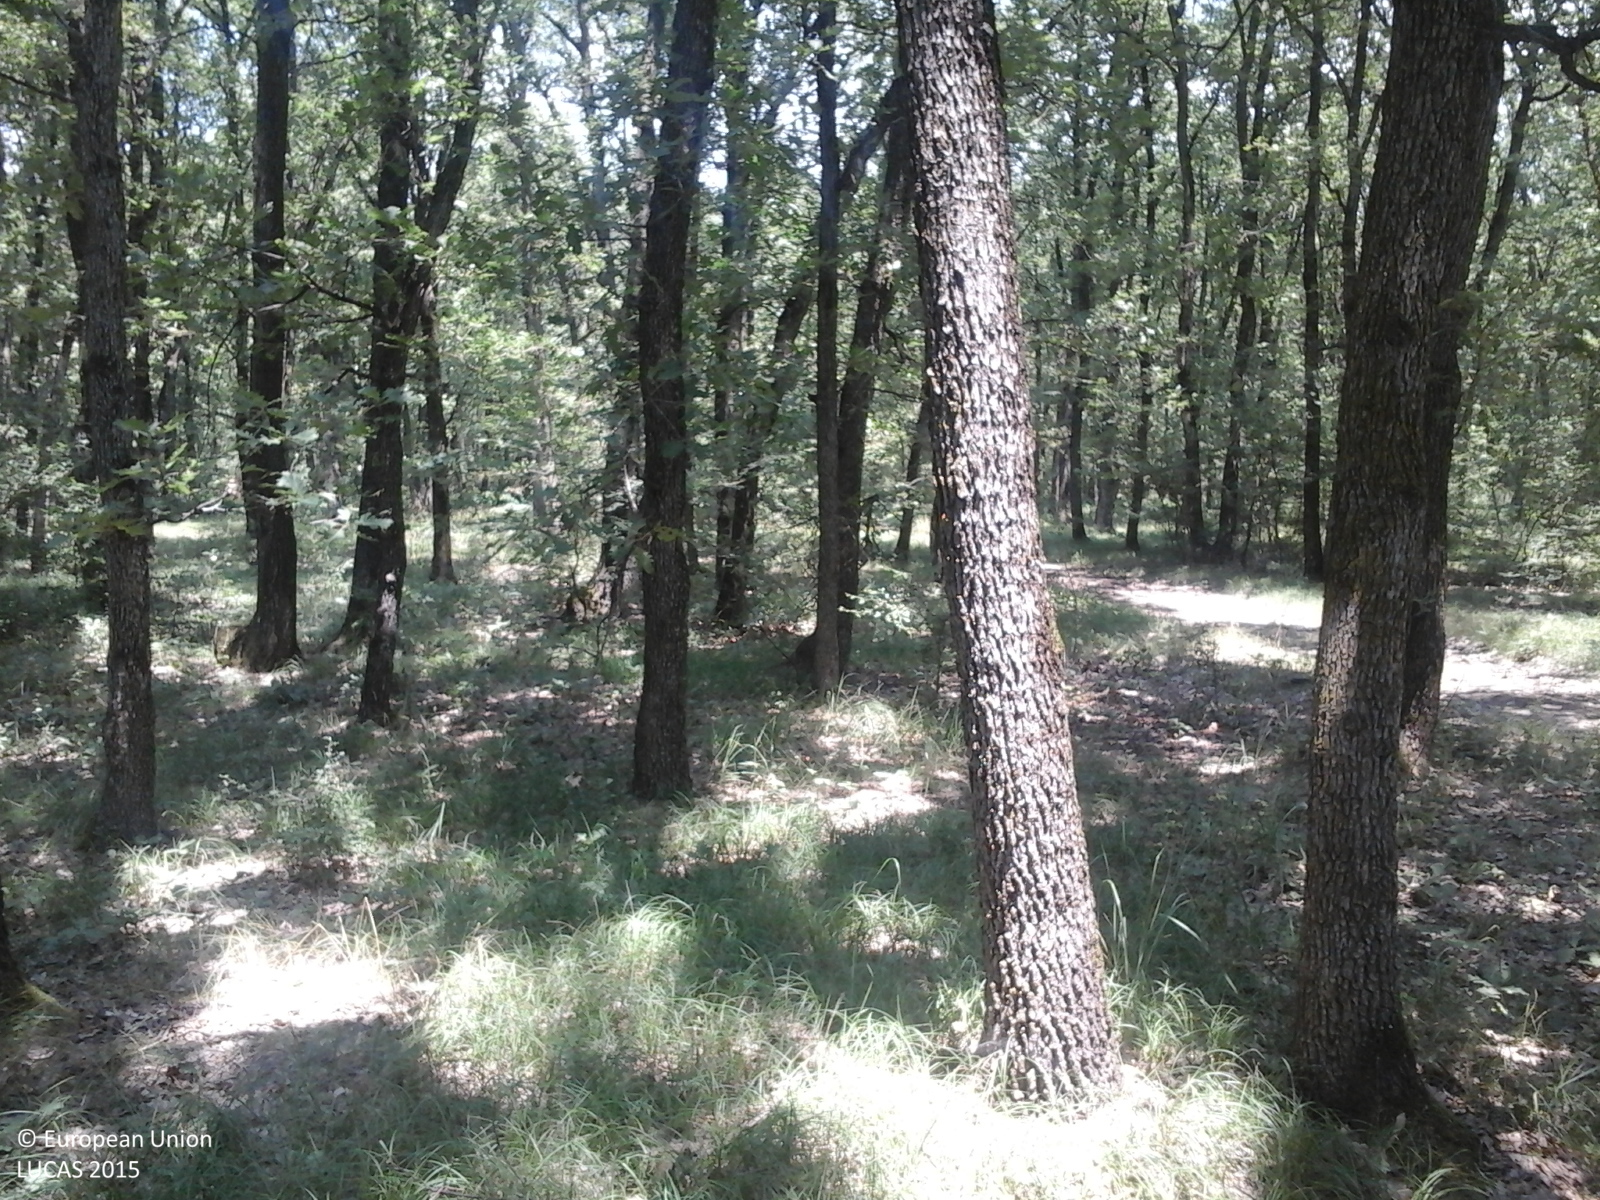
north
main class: Woodland
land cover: Broadleaved woodland
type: acidophilous oak and oak-birch forest
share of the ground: > 75 %
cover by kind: broadleaved forest trees 100 %
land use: Forestry
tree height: > 5 m
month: July
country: RO
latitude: 44.0764
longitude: 25.2539
